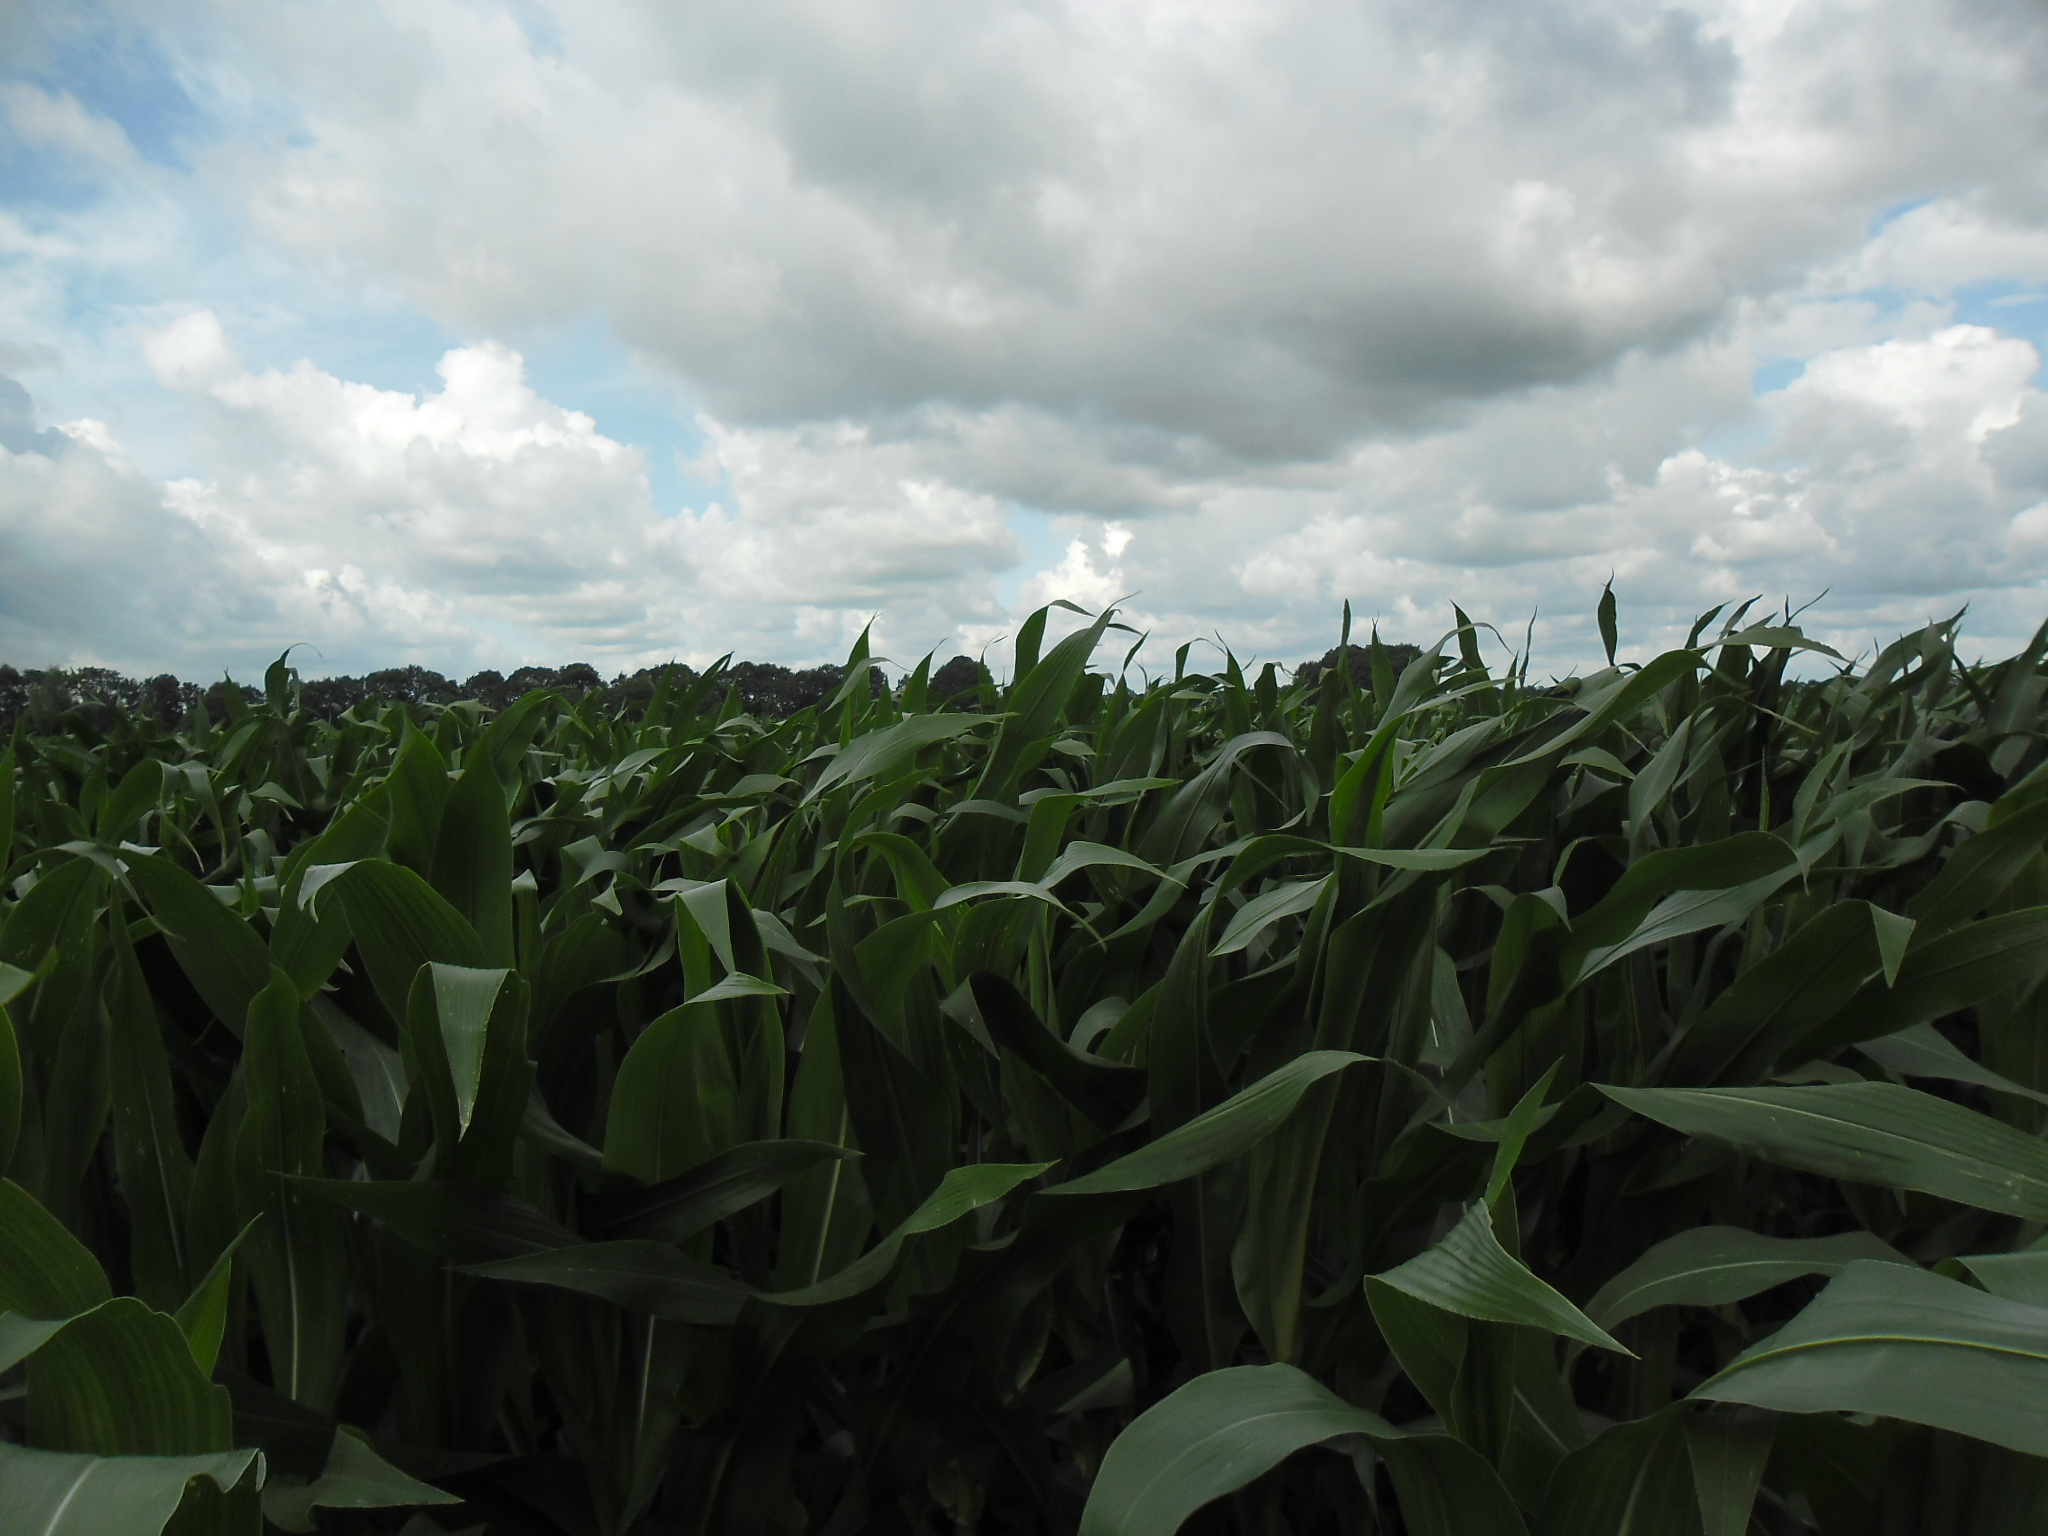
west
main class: Cropland
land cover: Maize
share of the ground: > 75 %
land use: Agriculture (excluding fallow land and kitchen gardens)
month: July
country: NL
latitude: 52.7294
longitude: 6.1642
